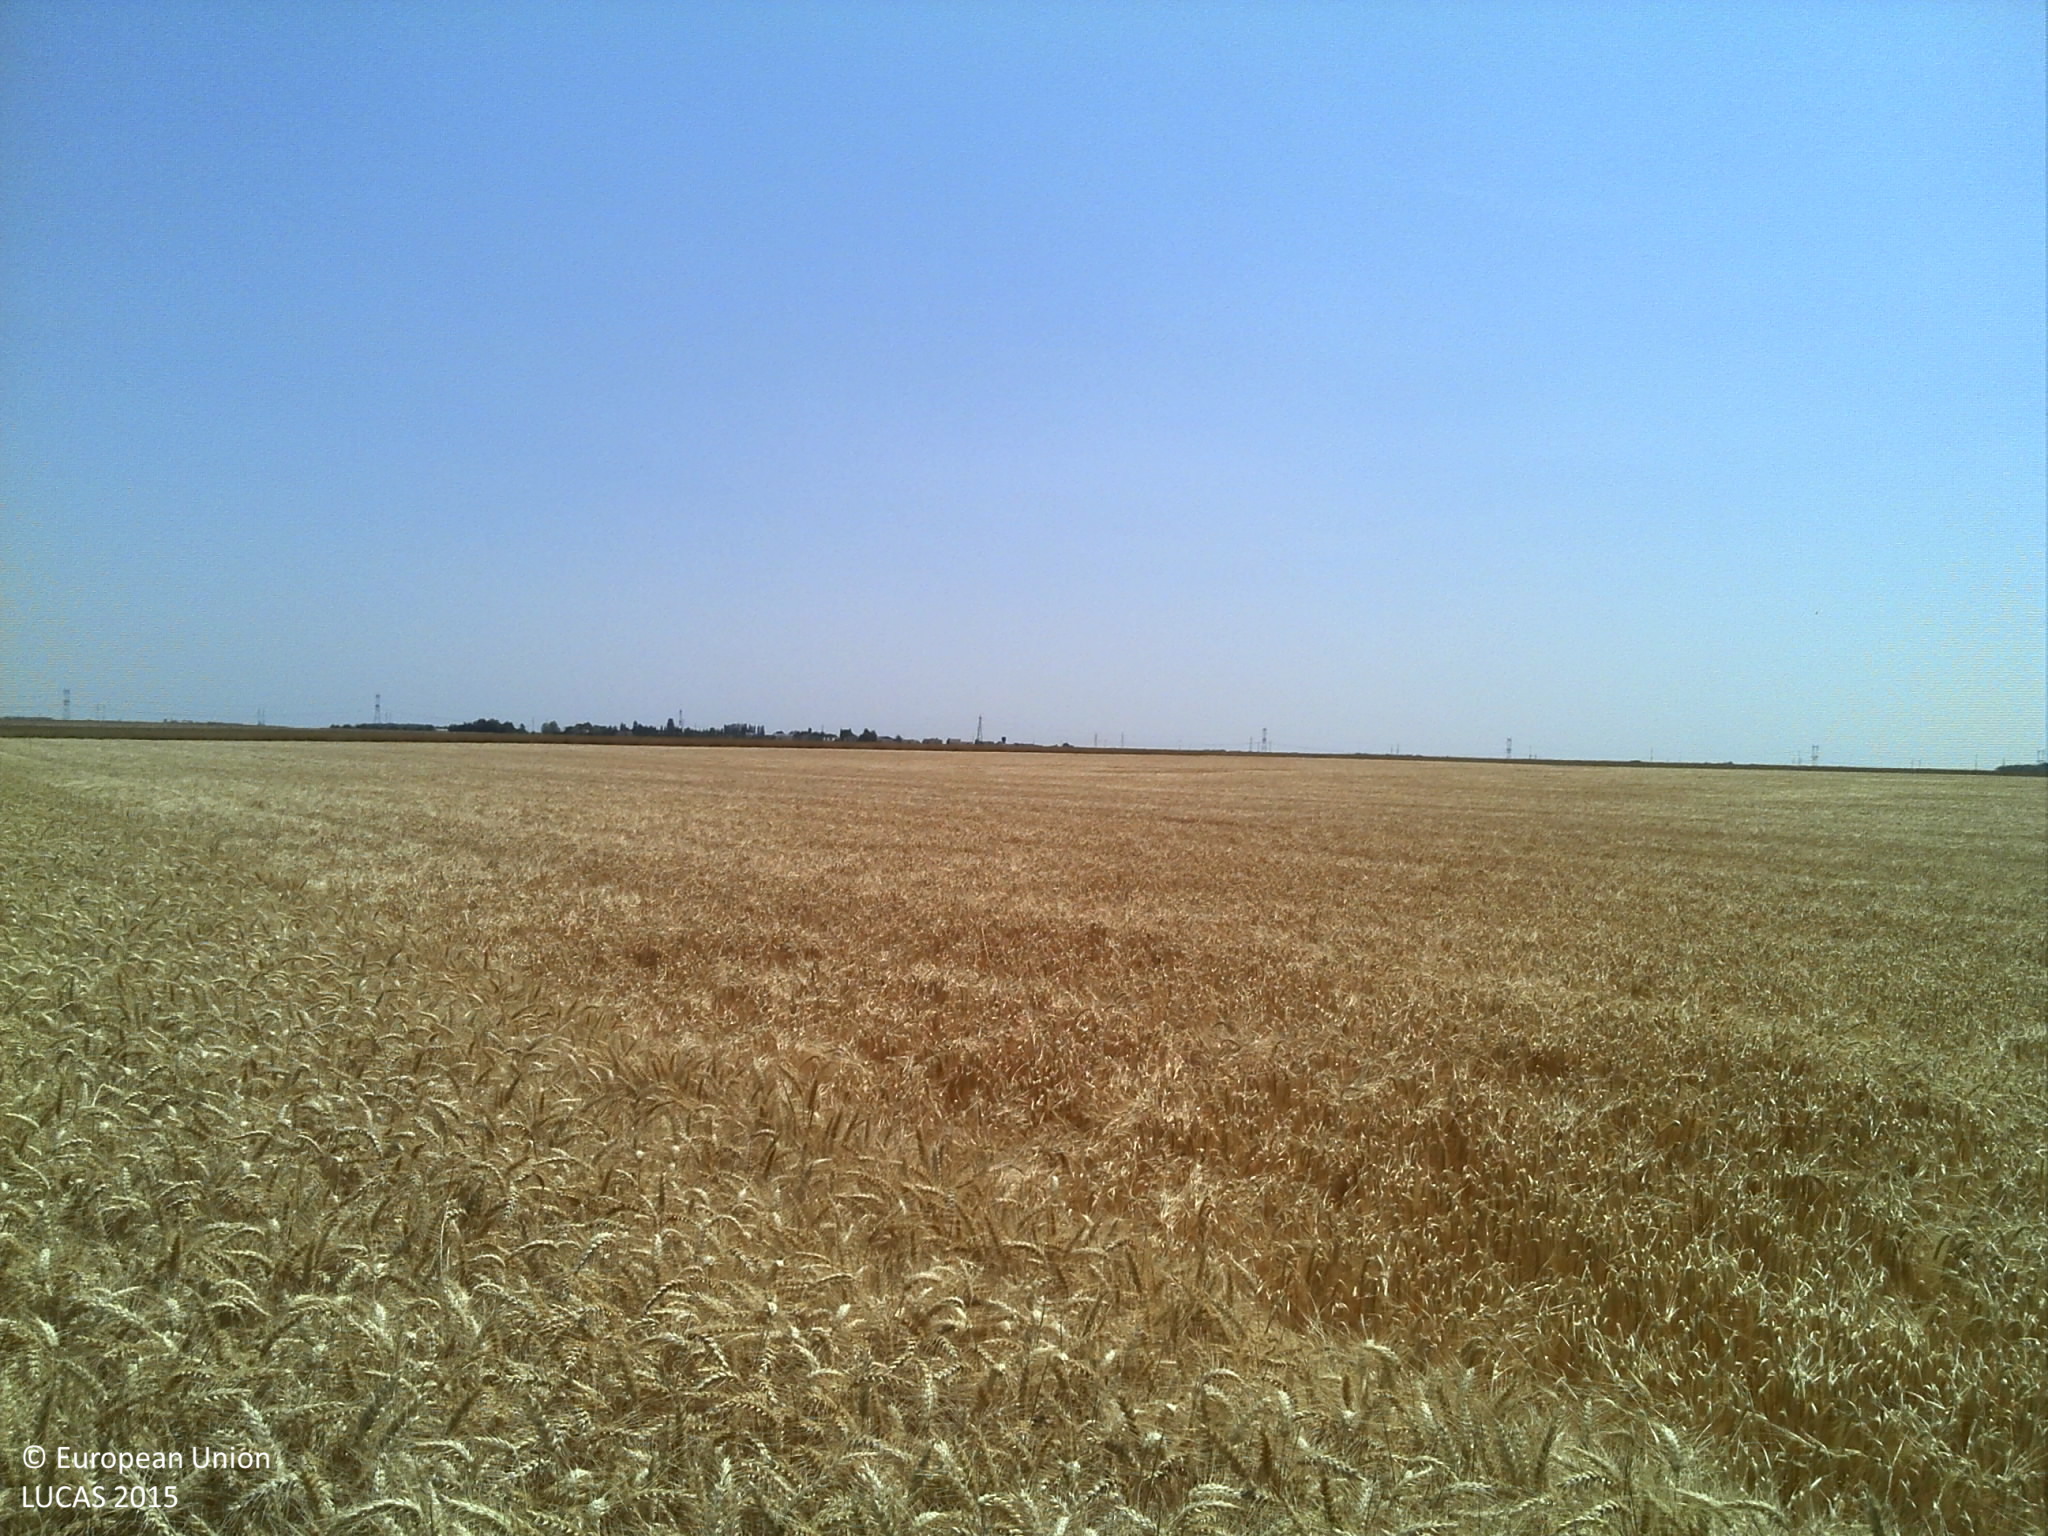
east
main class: Cropland
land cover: Durum wheat
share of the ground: > 75 %
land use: Agriculture (excluding fallow land and kitchen gardens)
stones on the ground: < 10 %
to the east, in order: Durum wheat; Barley
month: July
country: FR
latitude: 48.4188
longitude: 1.9738
